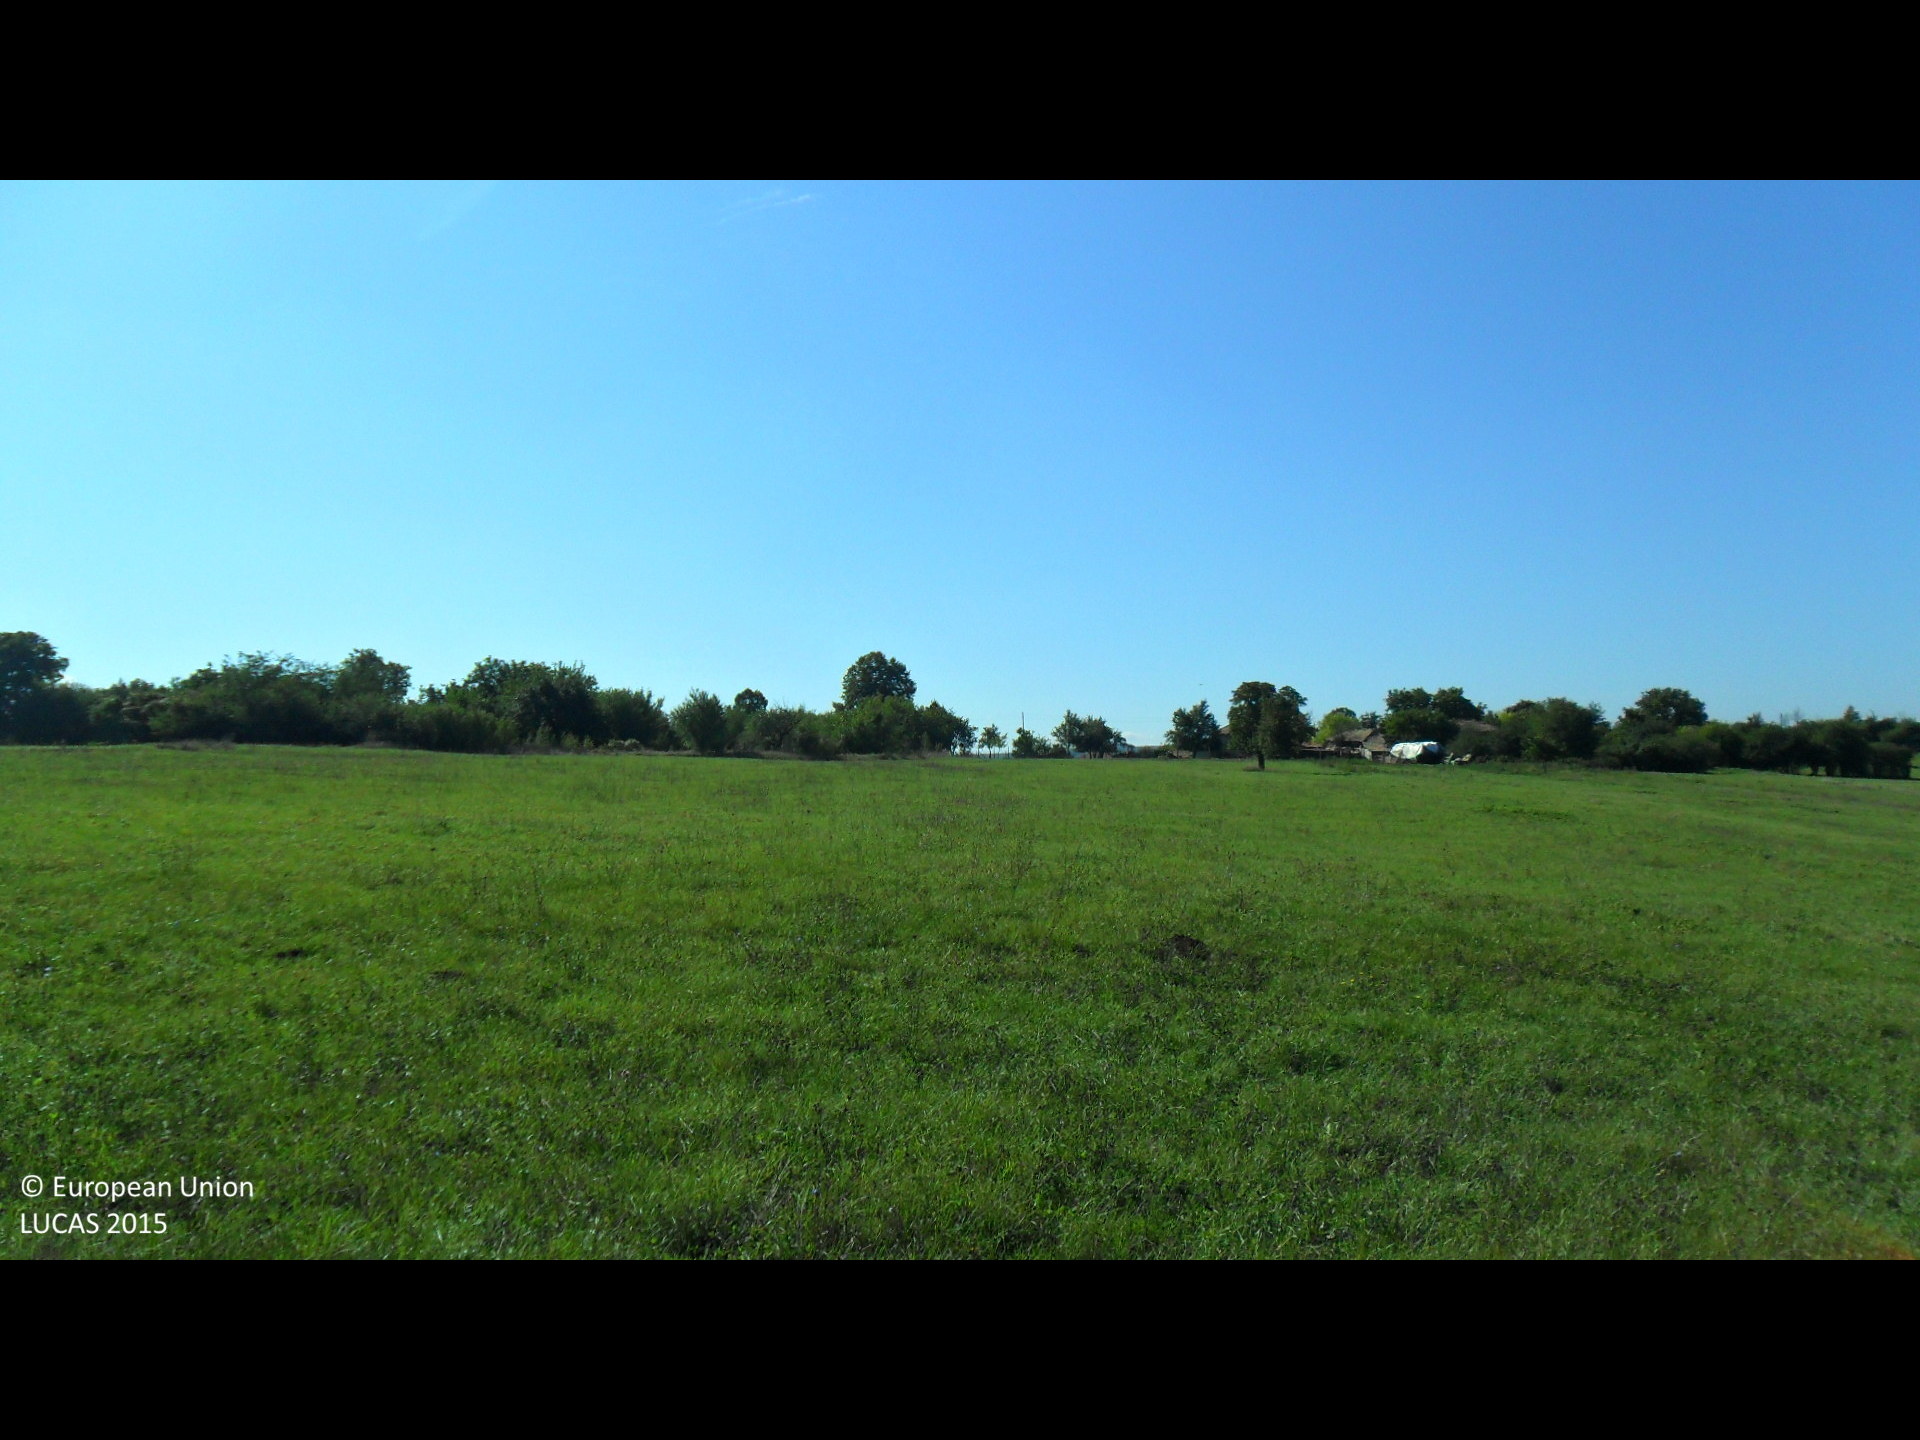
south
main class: Cropland
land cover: Common wheat
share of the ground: 25 - 50 %
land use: Agriculture (excluding fallow land and kitchen gardens)
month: October
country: BG
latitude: 43.1857
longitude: 26.1490
